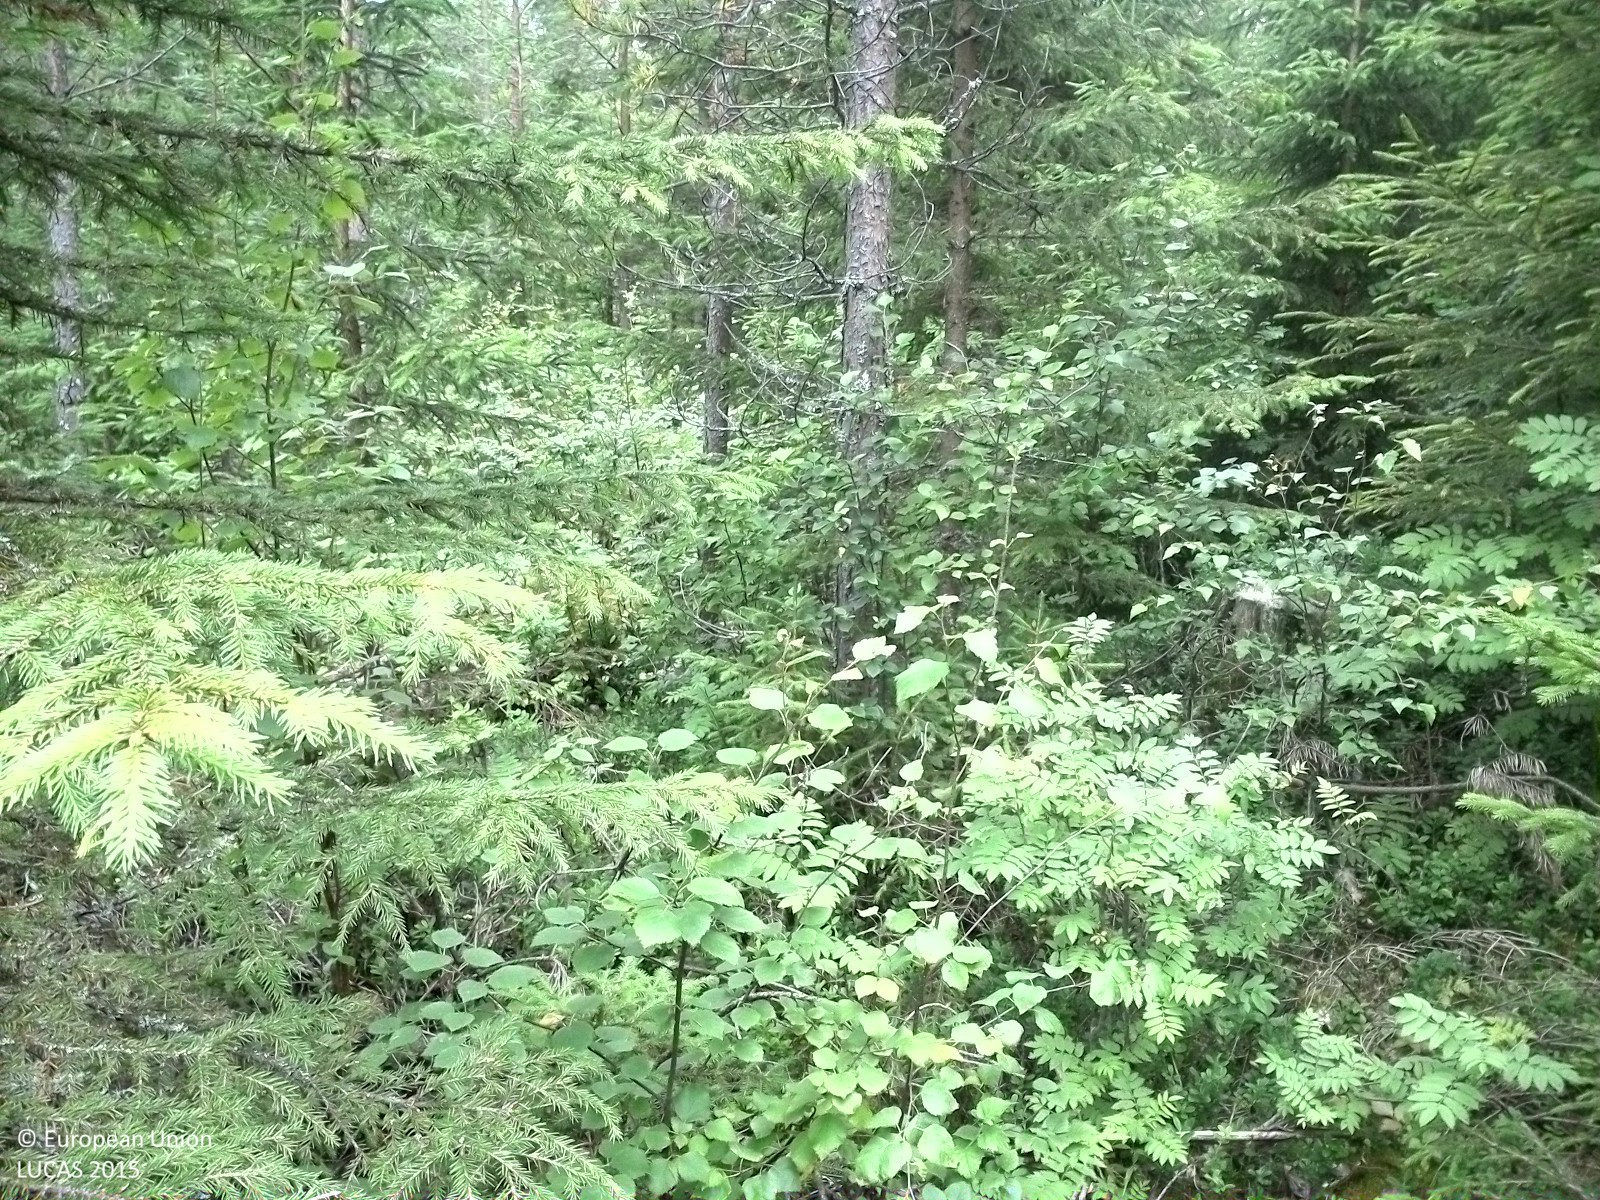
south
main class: Woodland
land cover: Spruce dominated coniferous woodland
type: boreal forest
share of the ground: 50 - 75 %
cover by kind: coniferous forest trees 60 %, shrubs 40 %
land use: Forestry
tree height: < 5 m
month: August
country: SE
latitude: 62.5564
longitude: 17.0393
